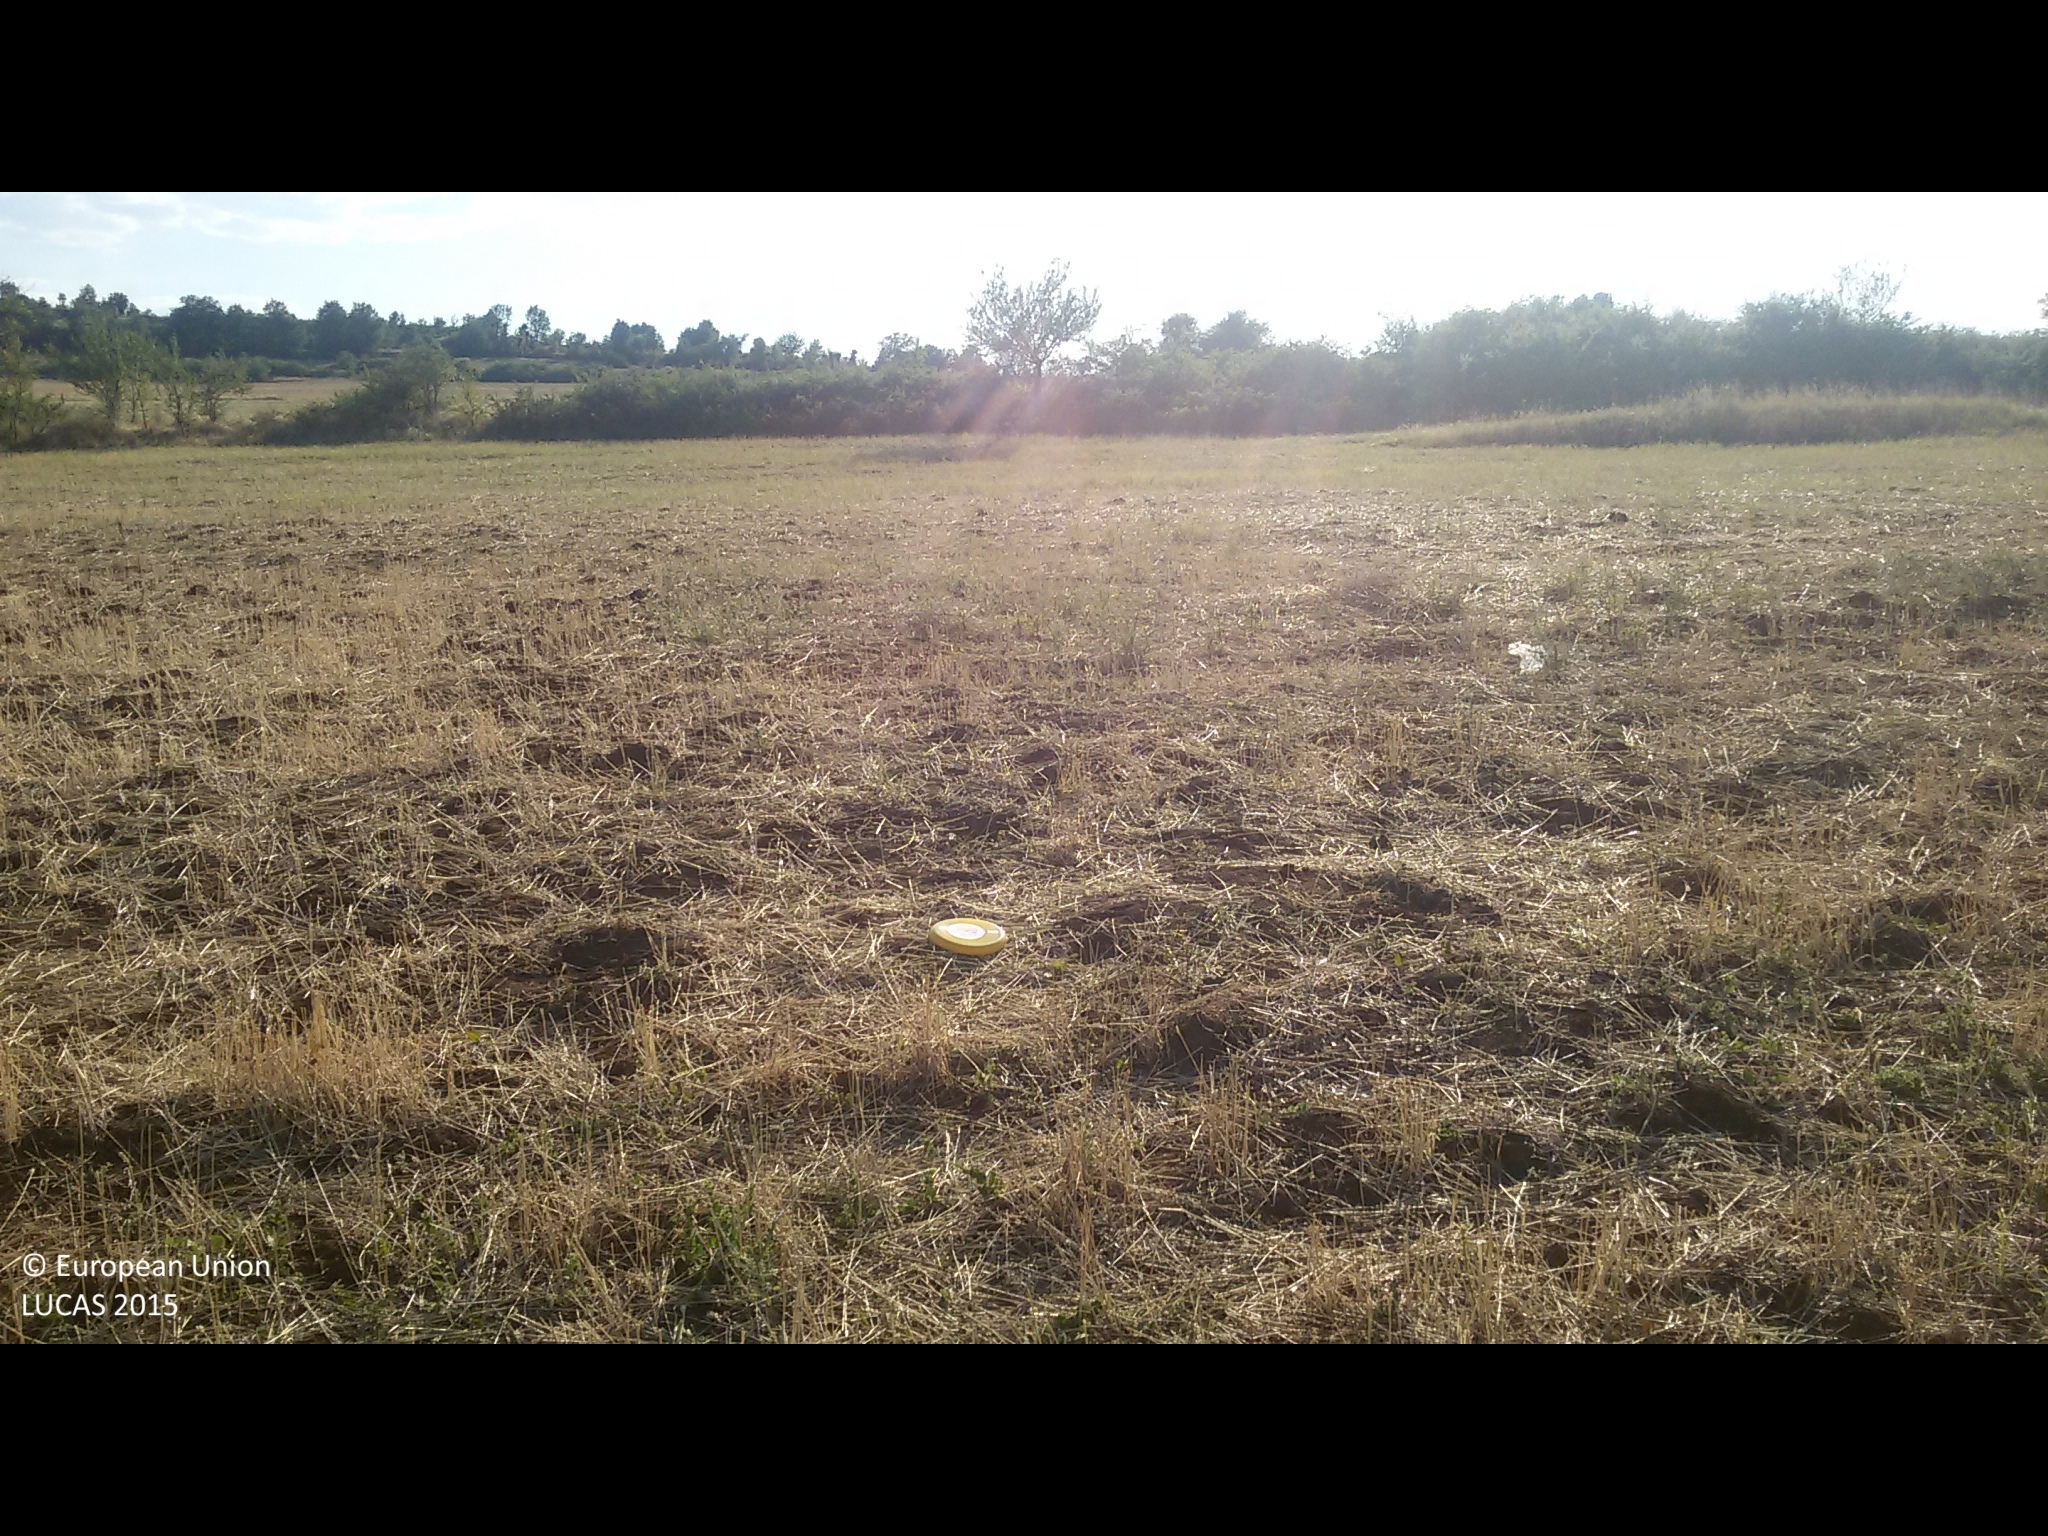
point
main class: Cropland
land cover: Common wheat
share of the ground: 50 - 75 %
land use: Agriculture (excluding fallow land and kitchen gardens)
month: August
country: BG
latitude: 41.9679
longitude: 23.0675
